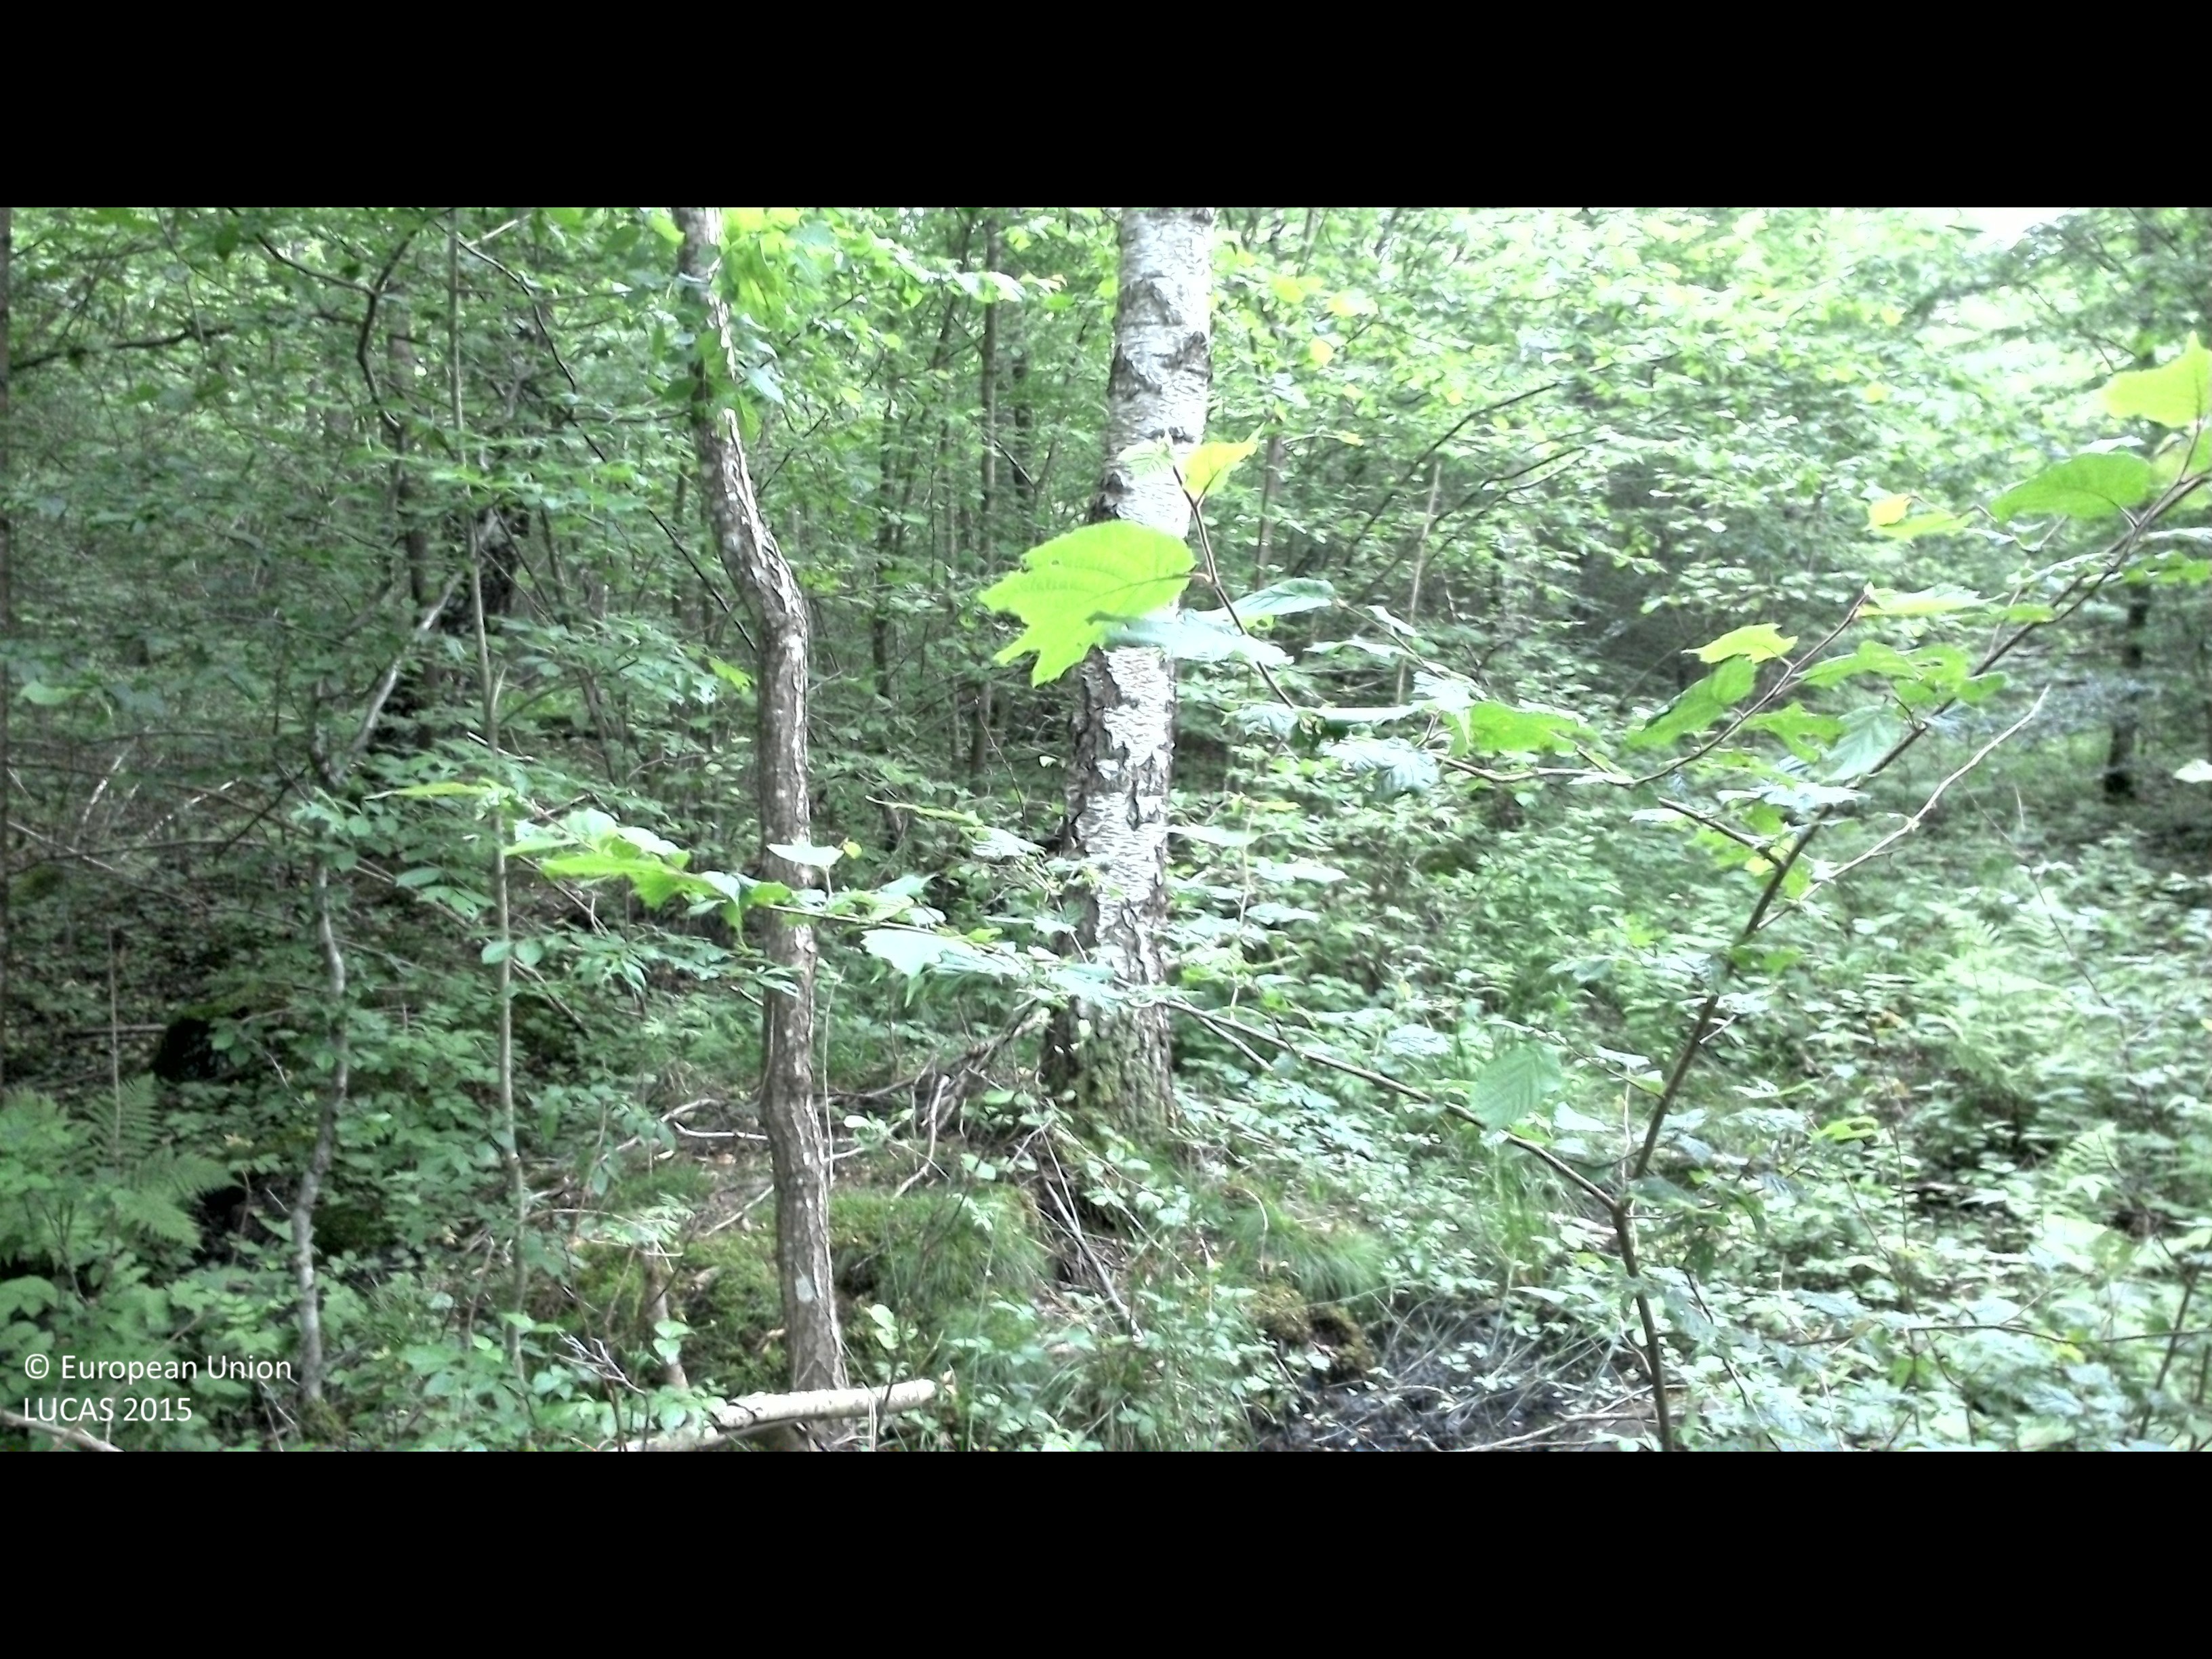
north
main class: Woodland
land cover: Broadleaved woodland
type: hemiboreal forest and nemoral coniferous forest and mixed broadleaved-coniferous forest
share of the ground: 50 - 75 %
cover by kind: broadleaved forest trees 65 %, shrubs 30 %, herbaceous plants 5 %
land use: Forestry
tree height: > 5 m
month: June
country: SE
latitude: 56.1782
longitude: 14.0410
